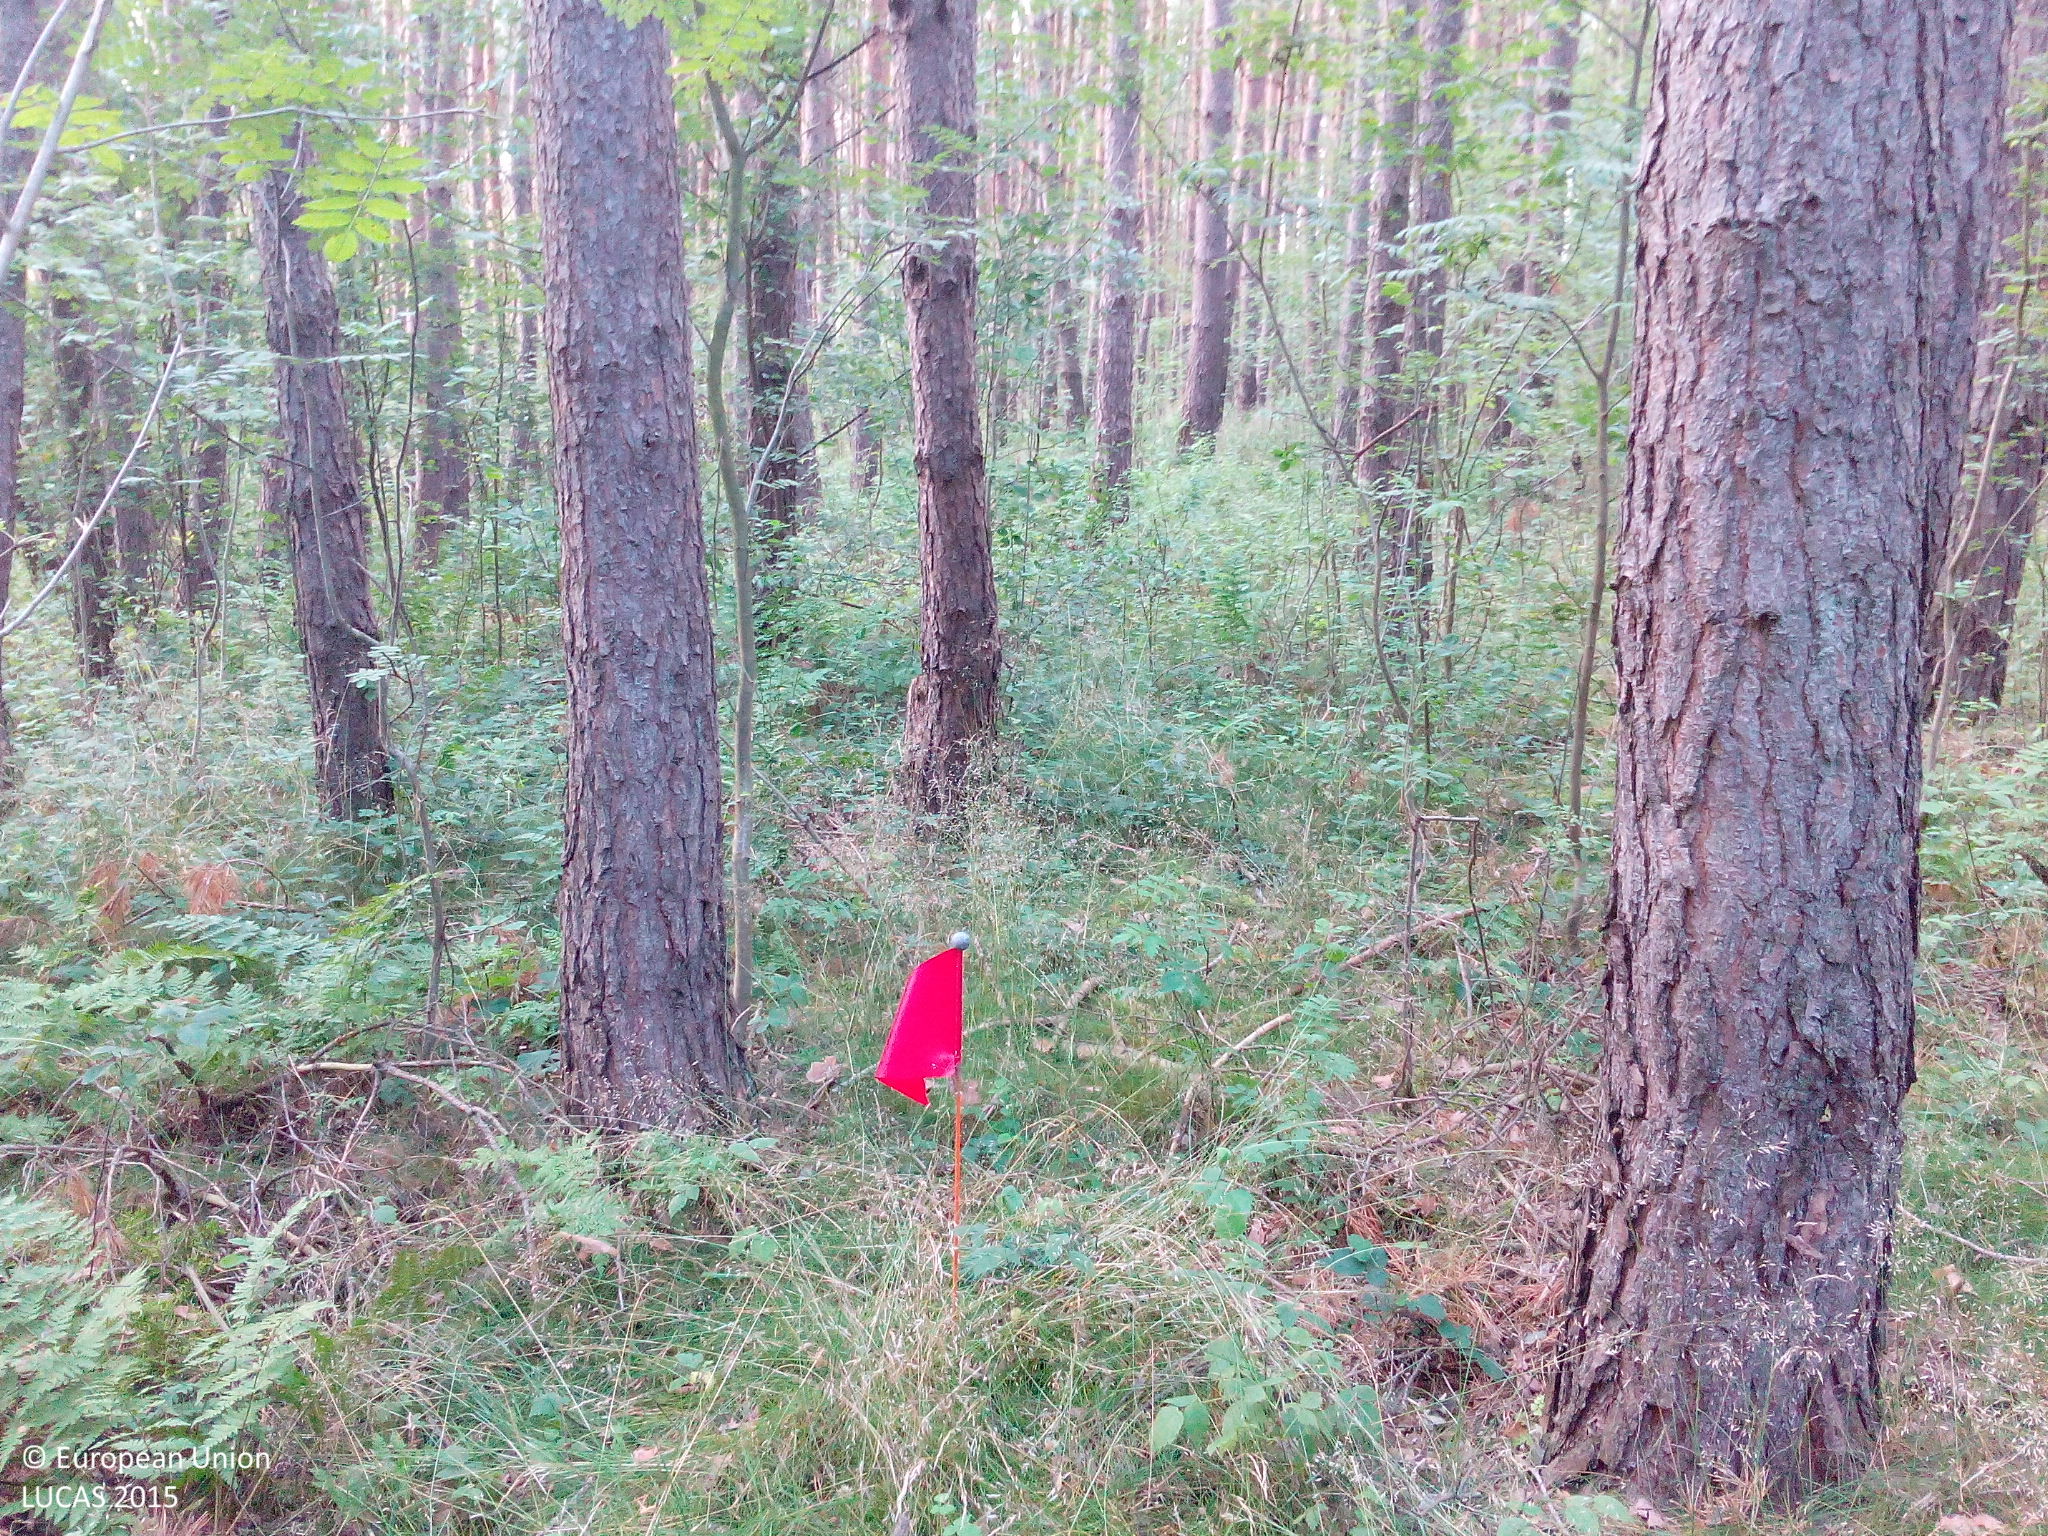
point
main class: Woodland
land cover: Pine dominated mixed woodland
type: hemiboreal forest and nemoral coniferous forest and mixed broadleaved-coniferous forest
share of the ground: 50 - 75 %
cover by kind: coniferous forest trees 45 %, broadleaved forest trees 25 %, shrubs 15 %, herbaceous plants 15 %
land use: Forestry
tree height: > 5 m
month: July
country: DE
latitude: 53.4878
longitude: 14.2960
